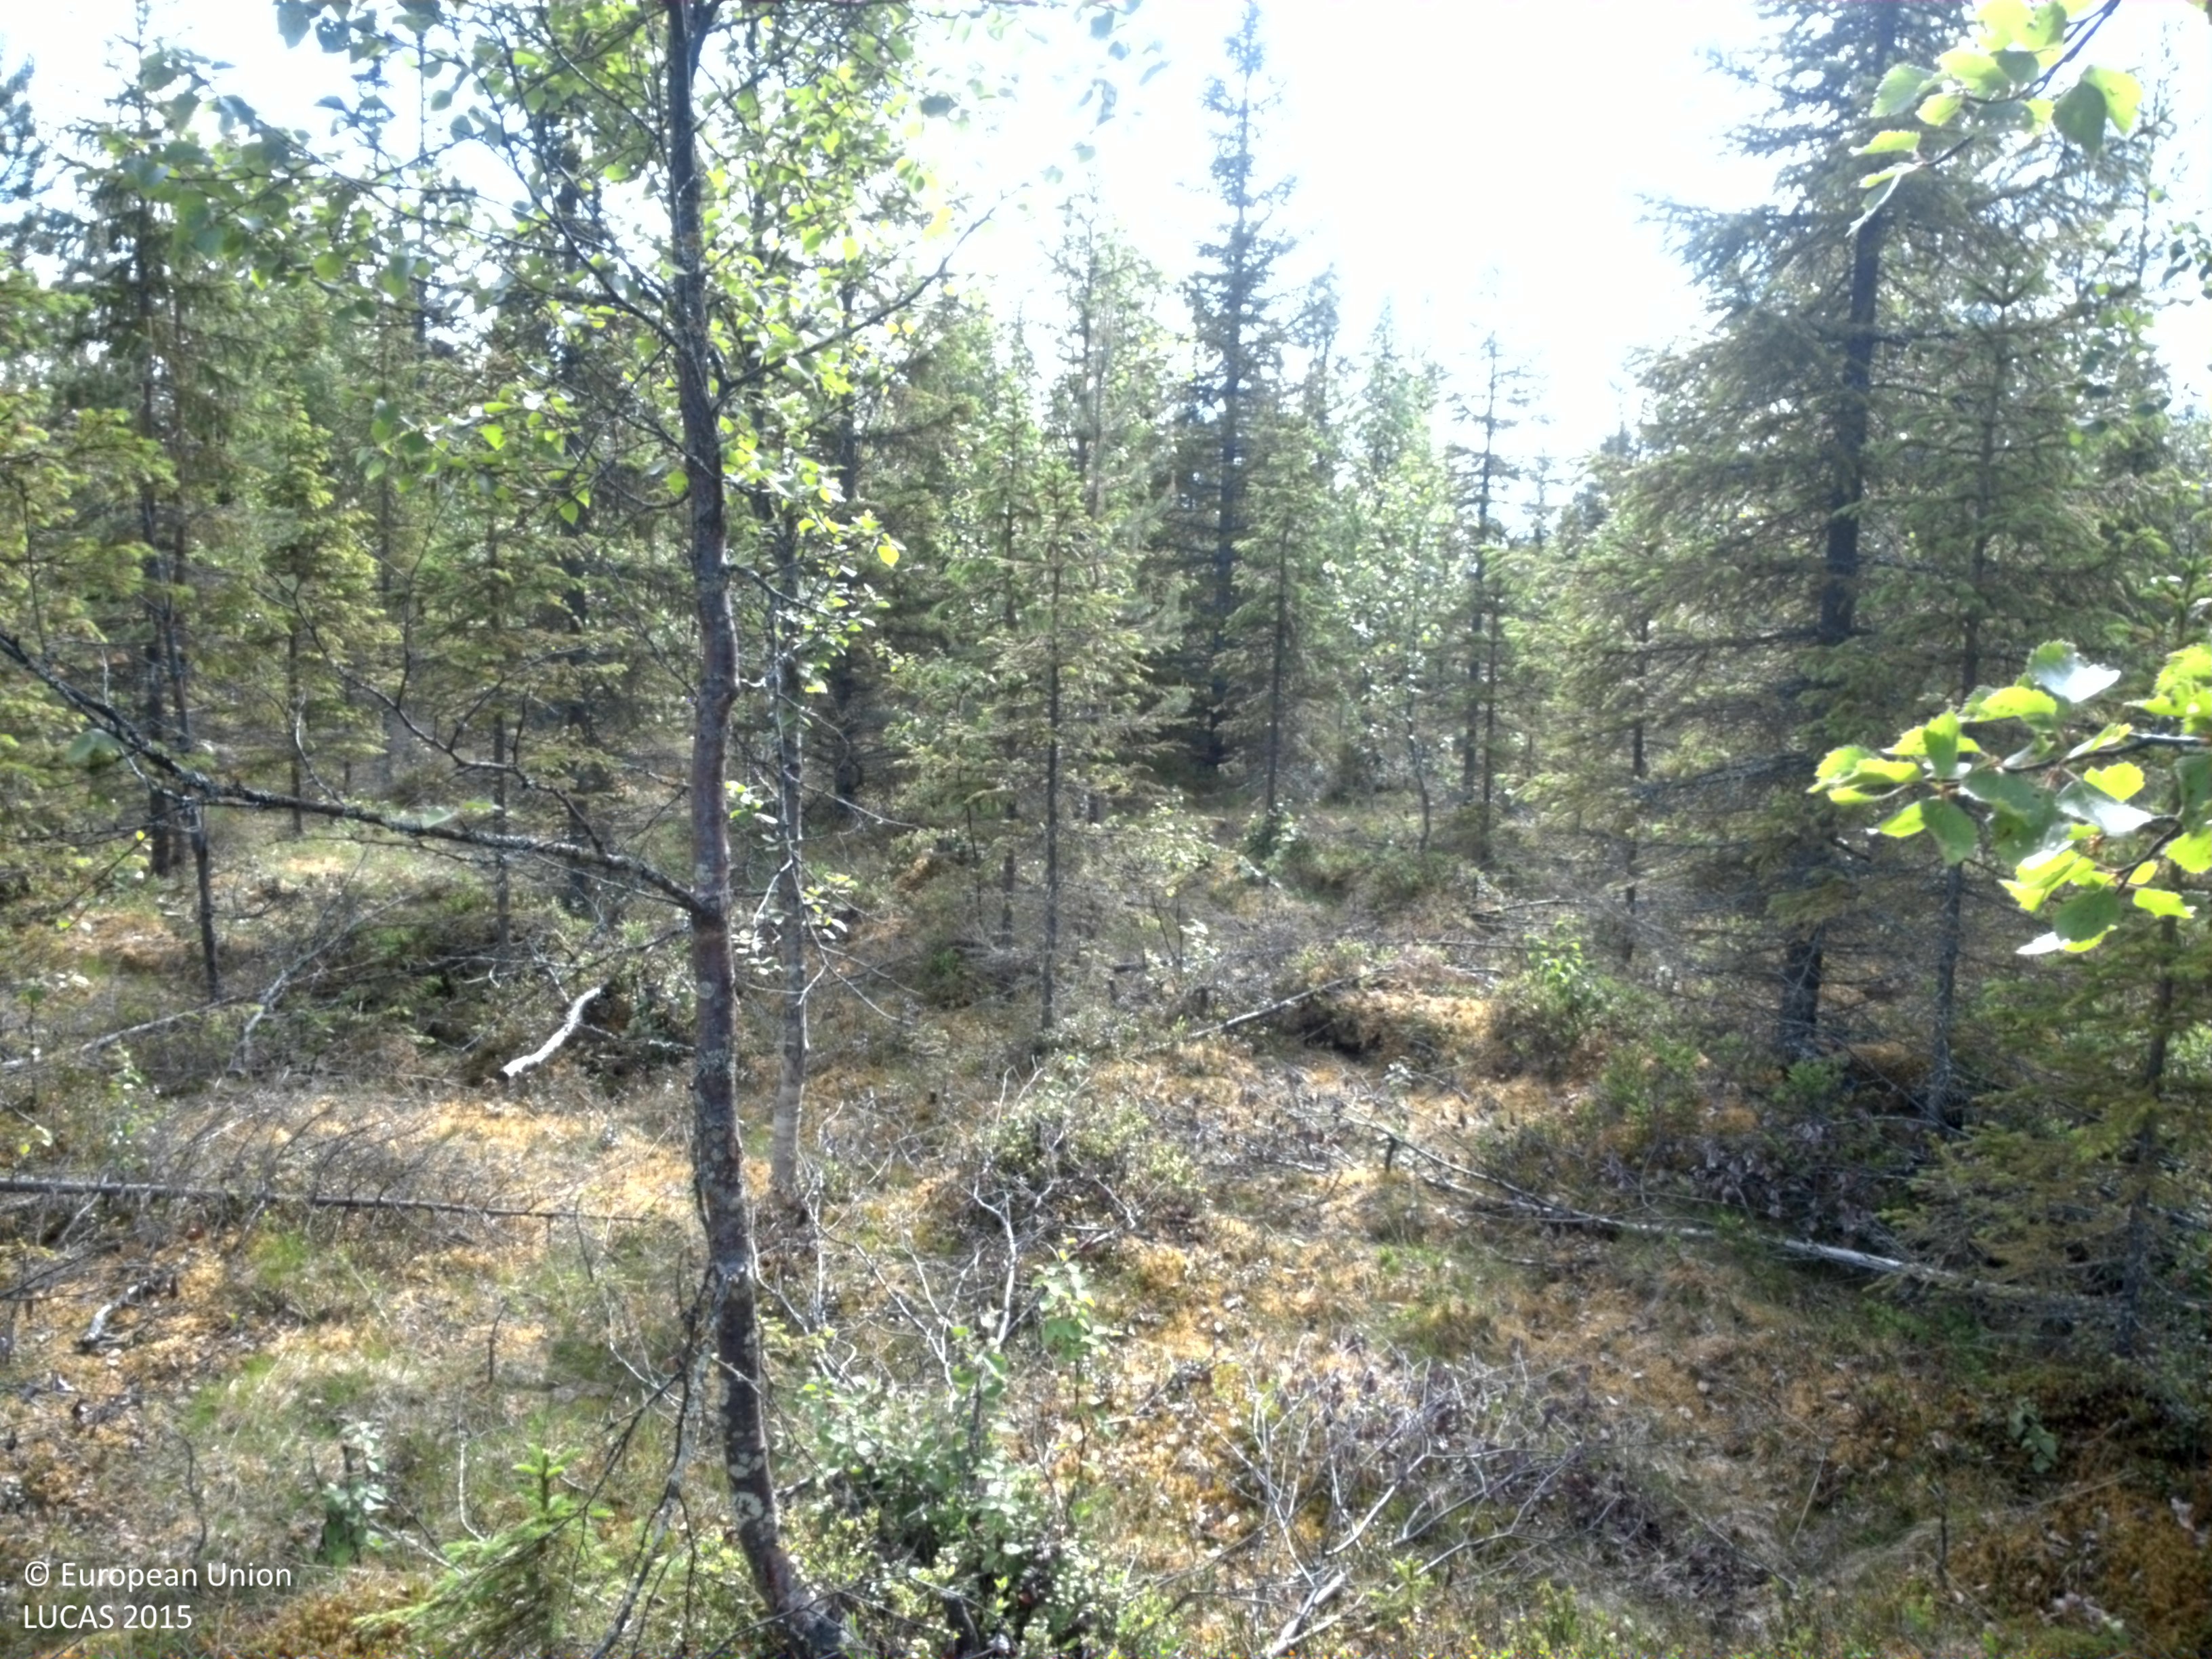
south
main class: Woodland
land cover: Spruce dominated mixed woodland
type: boreal forest
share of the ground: 25 - 50 %
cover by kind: coniferous forest trees 30 %, shrubs 25 %, lichens and mosses 25 %, broadleaved forest trees 10 %, herbaceous plants 10 %
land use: Forestry
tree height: < 5 m
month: July
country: SE
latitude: 64.4912
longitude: 18.2719
